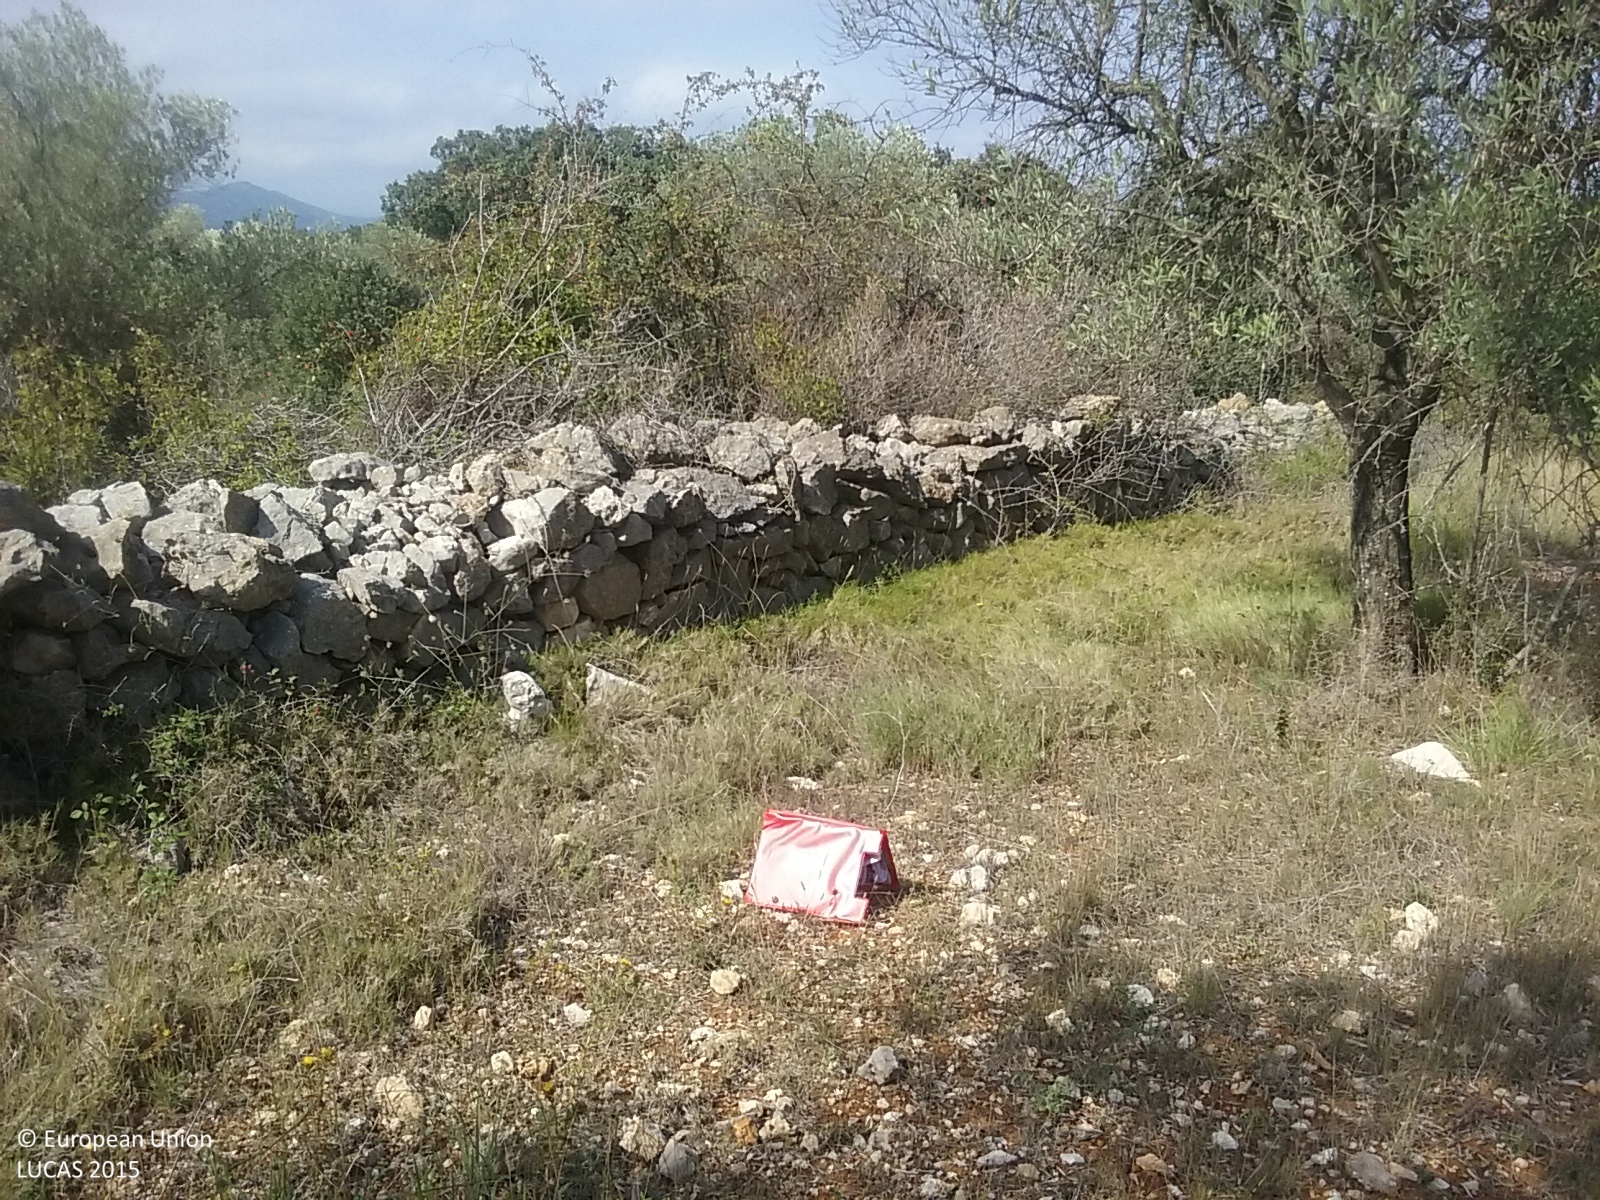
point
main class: Cropland
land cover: Olive groves
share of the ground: 25 - 50 %
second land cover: Spontaneously vegetated surfaces
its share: 25 - 50 %
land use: Agriculture (excluding fallow land and kitchen gardens)
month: August
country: ES
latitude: 40.3383
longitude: 0.0018
